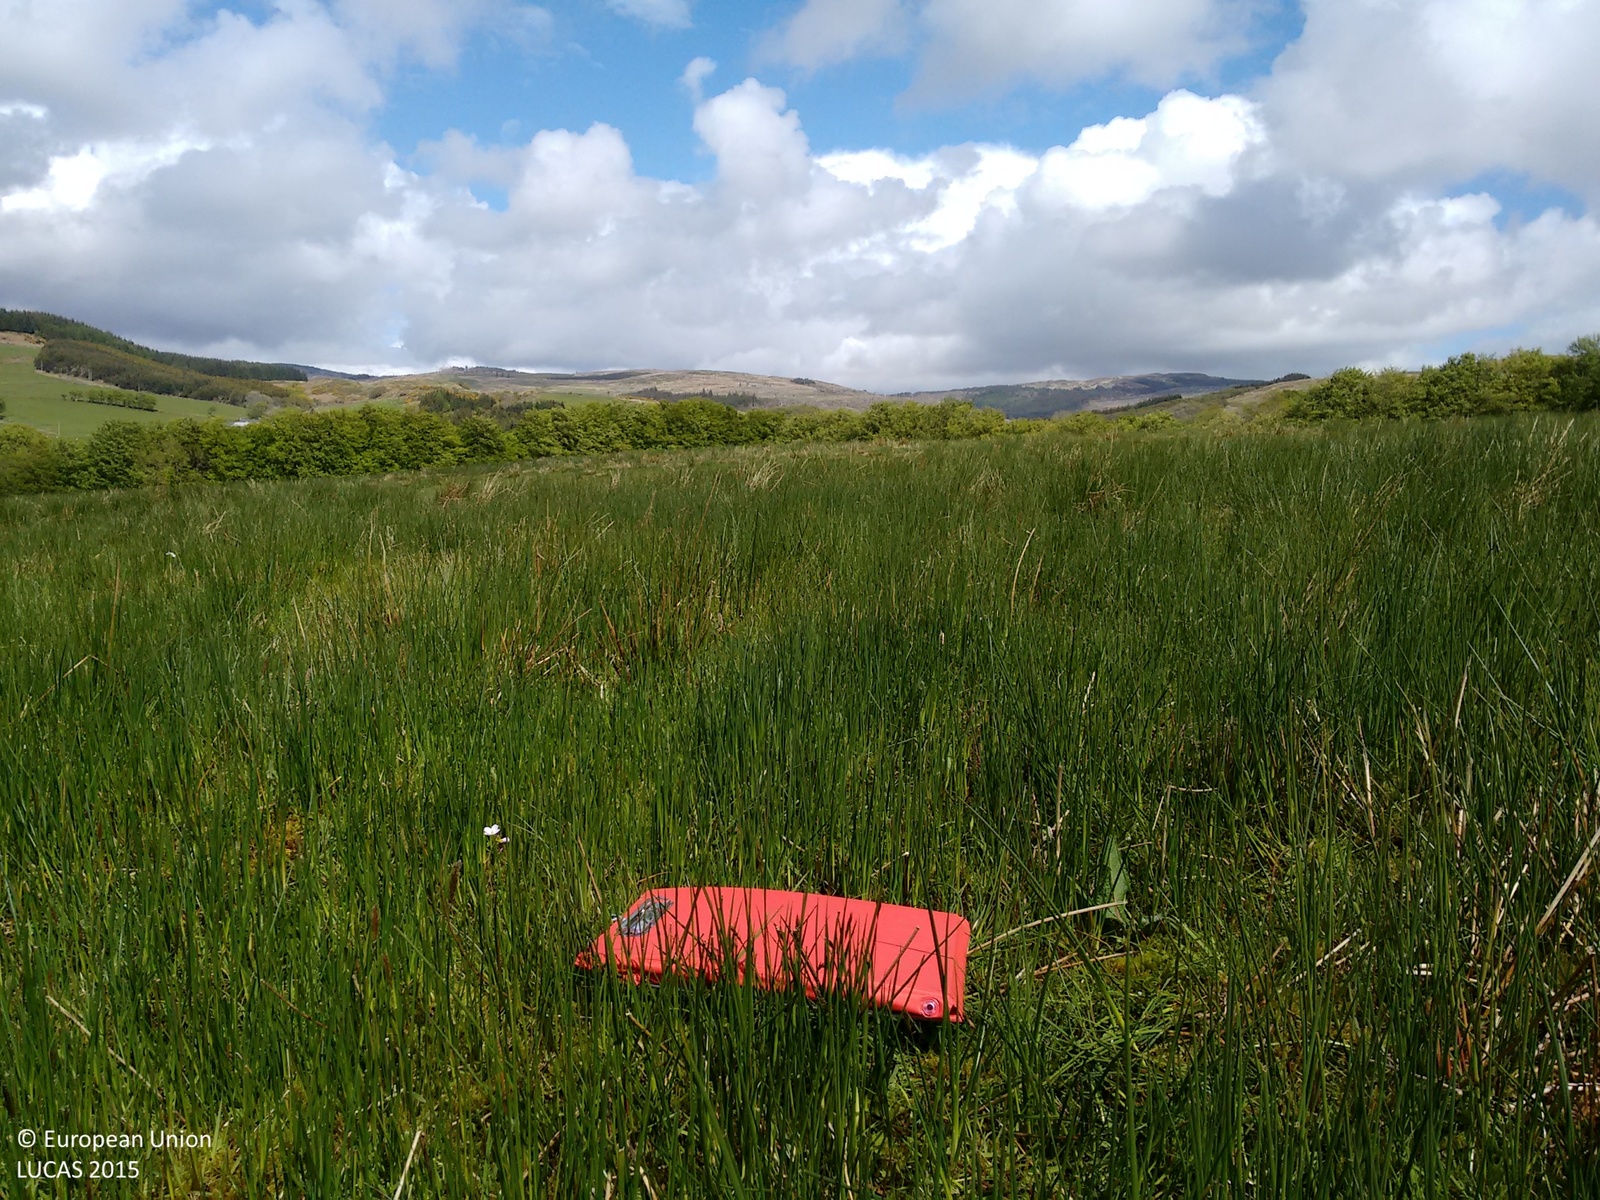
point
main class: Grassland
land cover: Grassland without tree/shrub cover
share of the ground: > 75 %
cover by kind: herbaceous plants 100 %
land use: Agriculture (excluding fallow land and kitchen gardens)
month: May
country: GB
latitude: 55.9570
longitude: -5.3180
